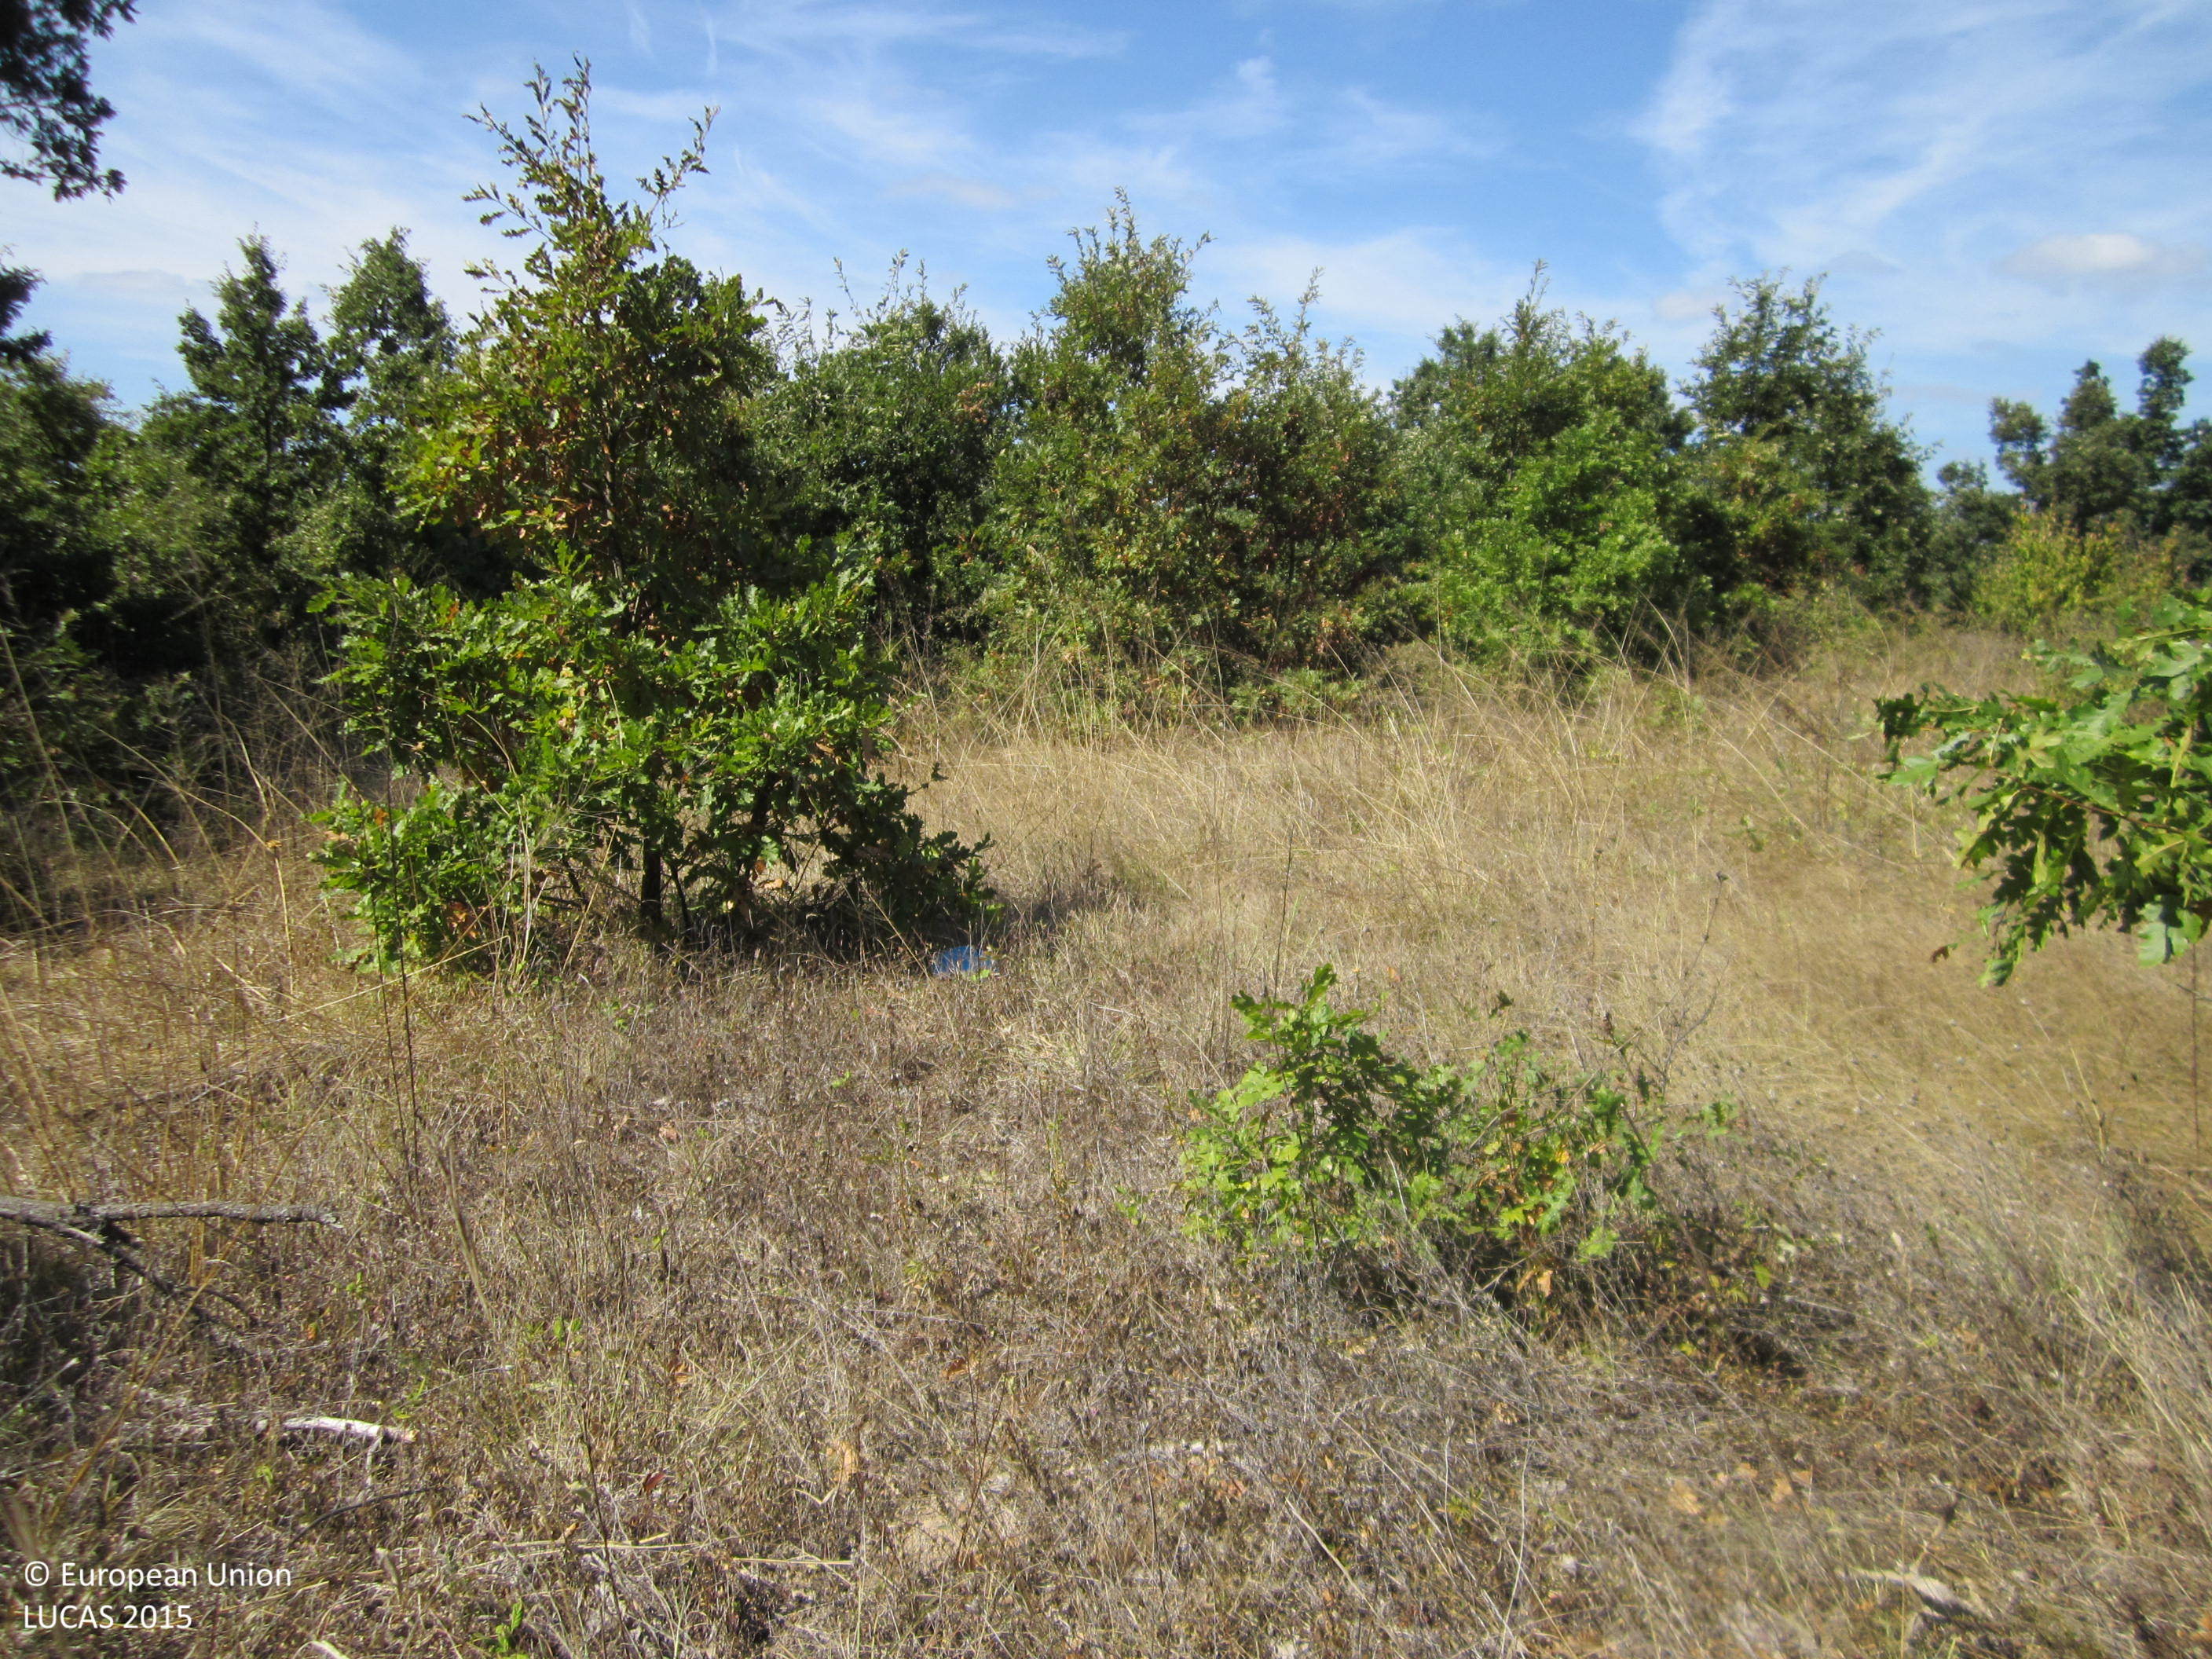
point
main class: Woodland
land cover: Broadleaved woodland
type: thermophilous deciduous forest
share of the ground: 25 - 50 %
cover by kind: broadleaved forest trees 45 %, herbaceous plants 45 %, shrubs 10 %
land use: Forestry
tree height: > 5 m
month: September
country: BG
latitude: 42.1525
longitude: 27.0558
